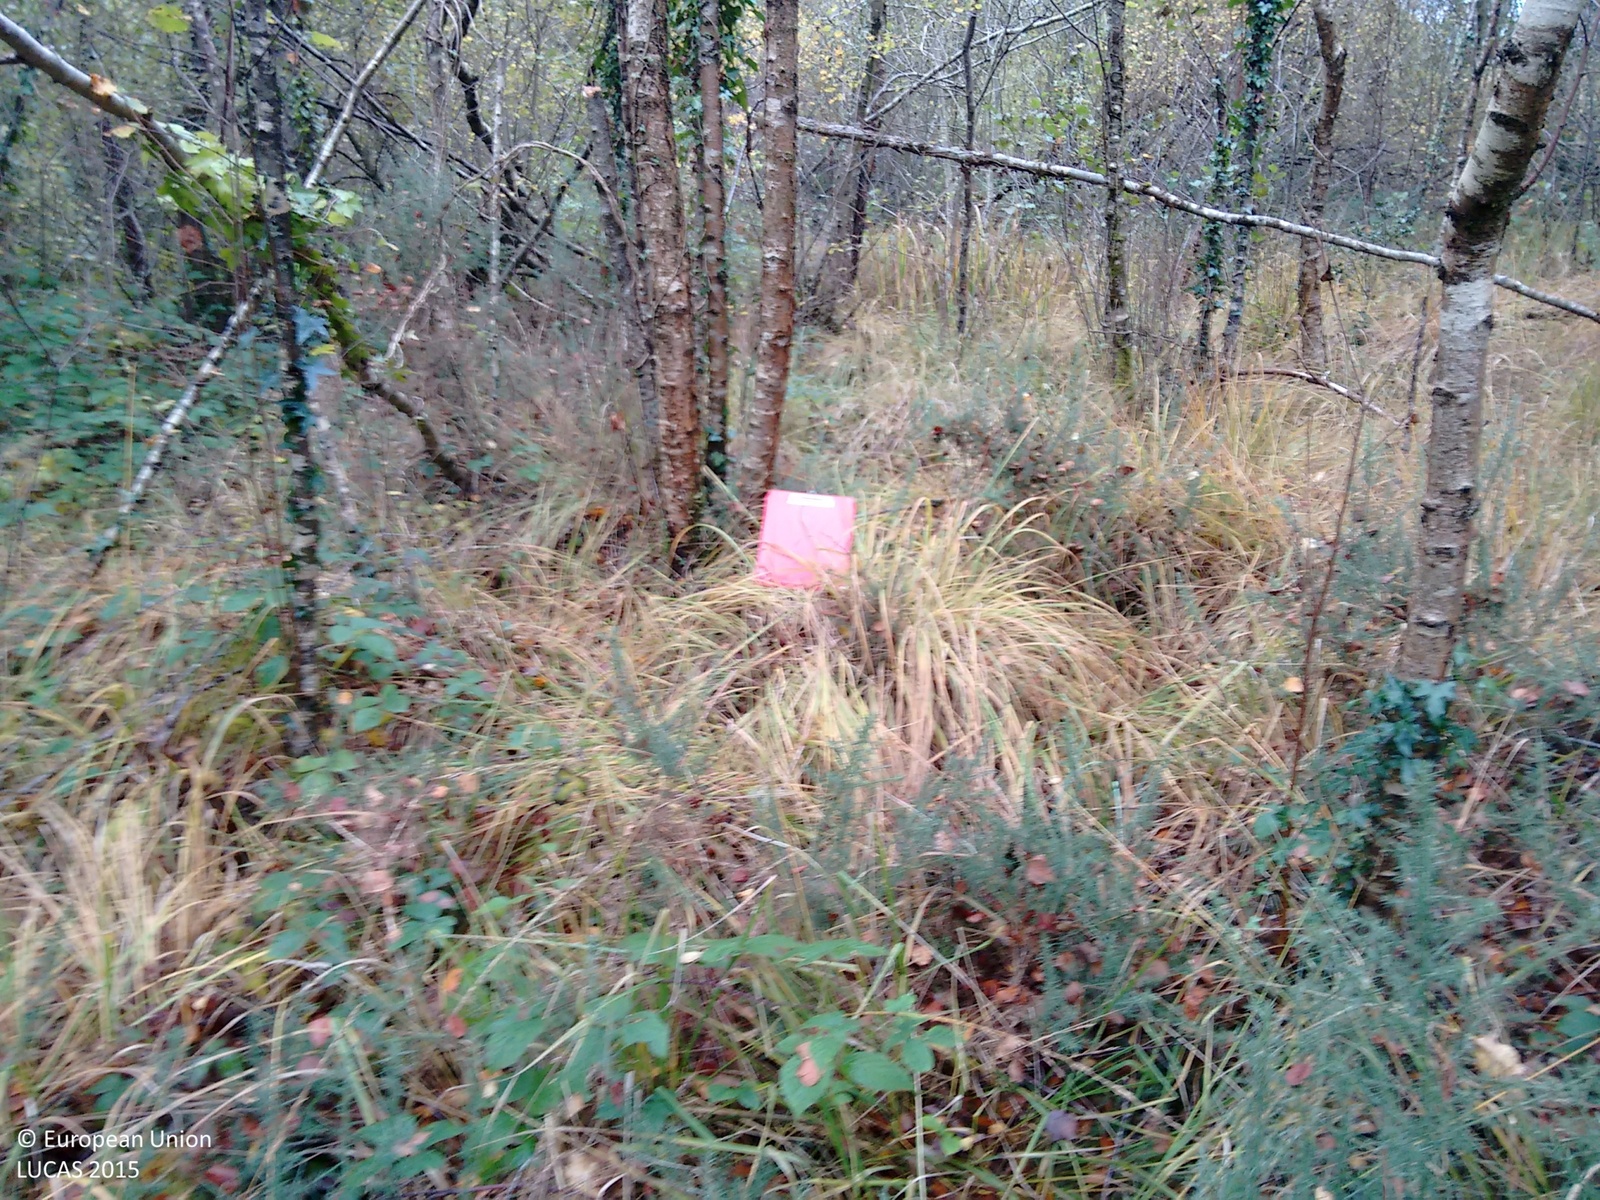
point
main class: Woodland
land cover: Other mixed woodland
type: acidophilous oak and oak-birch forest
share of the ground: > 75 %
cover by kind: broadleaved forest trees 60 %, coniferous forest trees 40 %
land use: Semi-natural and natural areas not in use
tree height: > 5 m
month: October
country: IE
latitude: 53.2248
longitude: -7.5812
